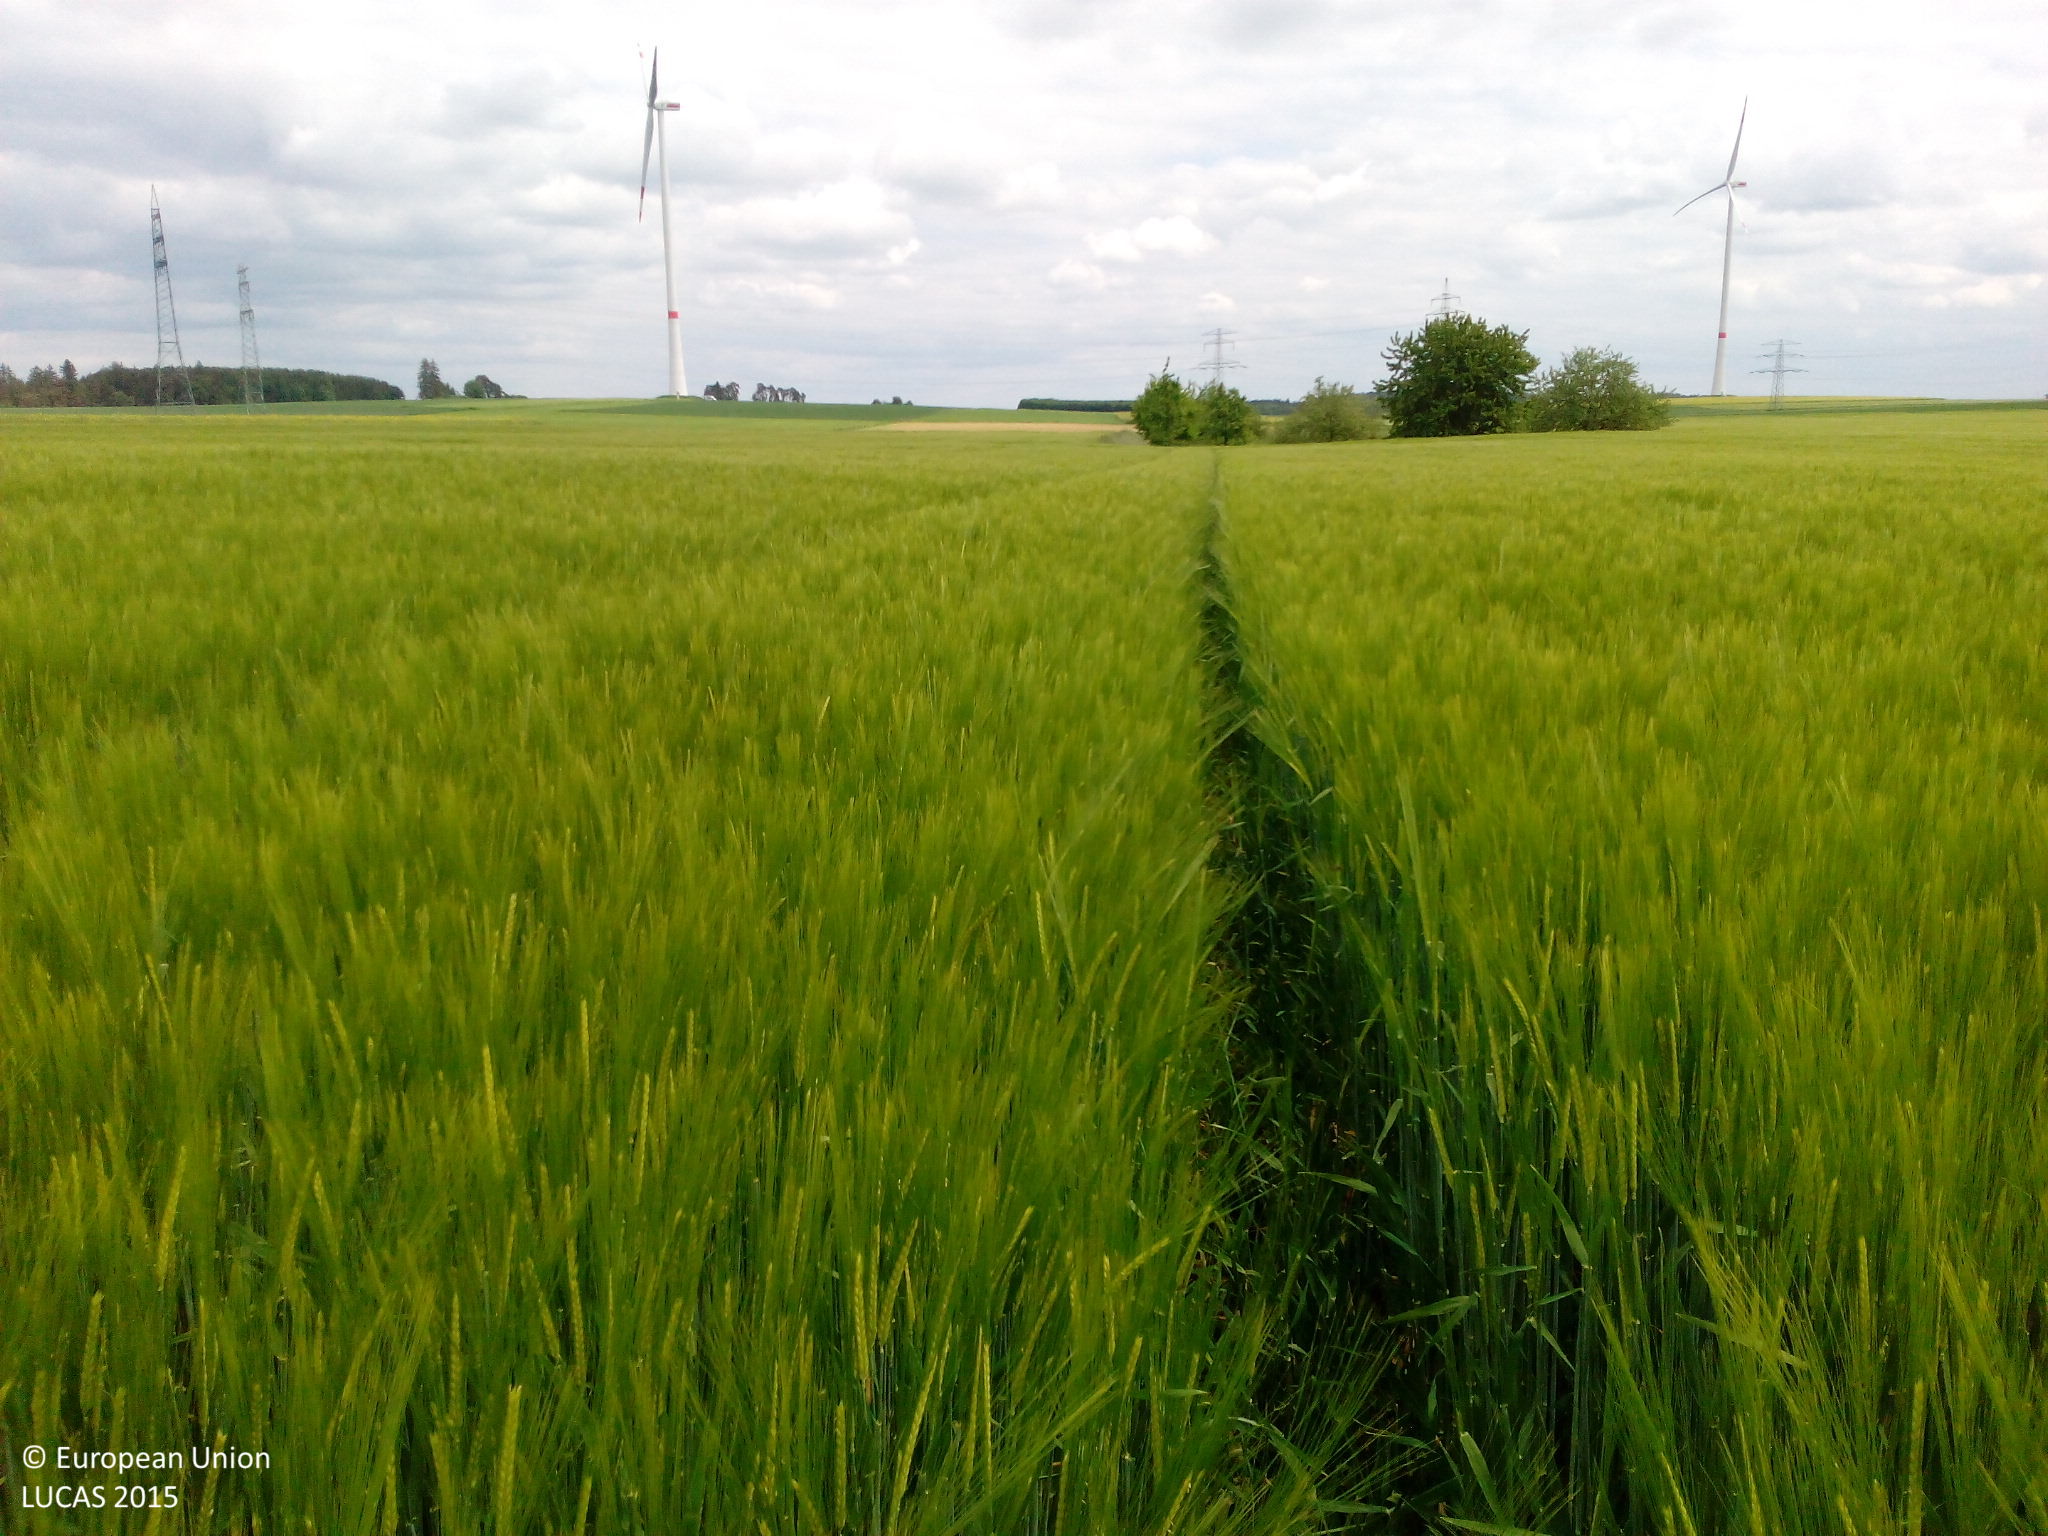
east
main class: Cropland
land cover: Barley
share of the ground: > 75 %
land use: Agriculture (excluding fallow land and kitchen gardens)
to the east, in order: Barley; Tracks; Grass margins; Maize
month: May
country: DE
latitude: 49.0952
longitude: 11.4922
